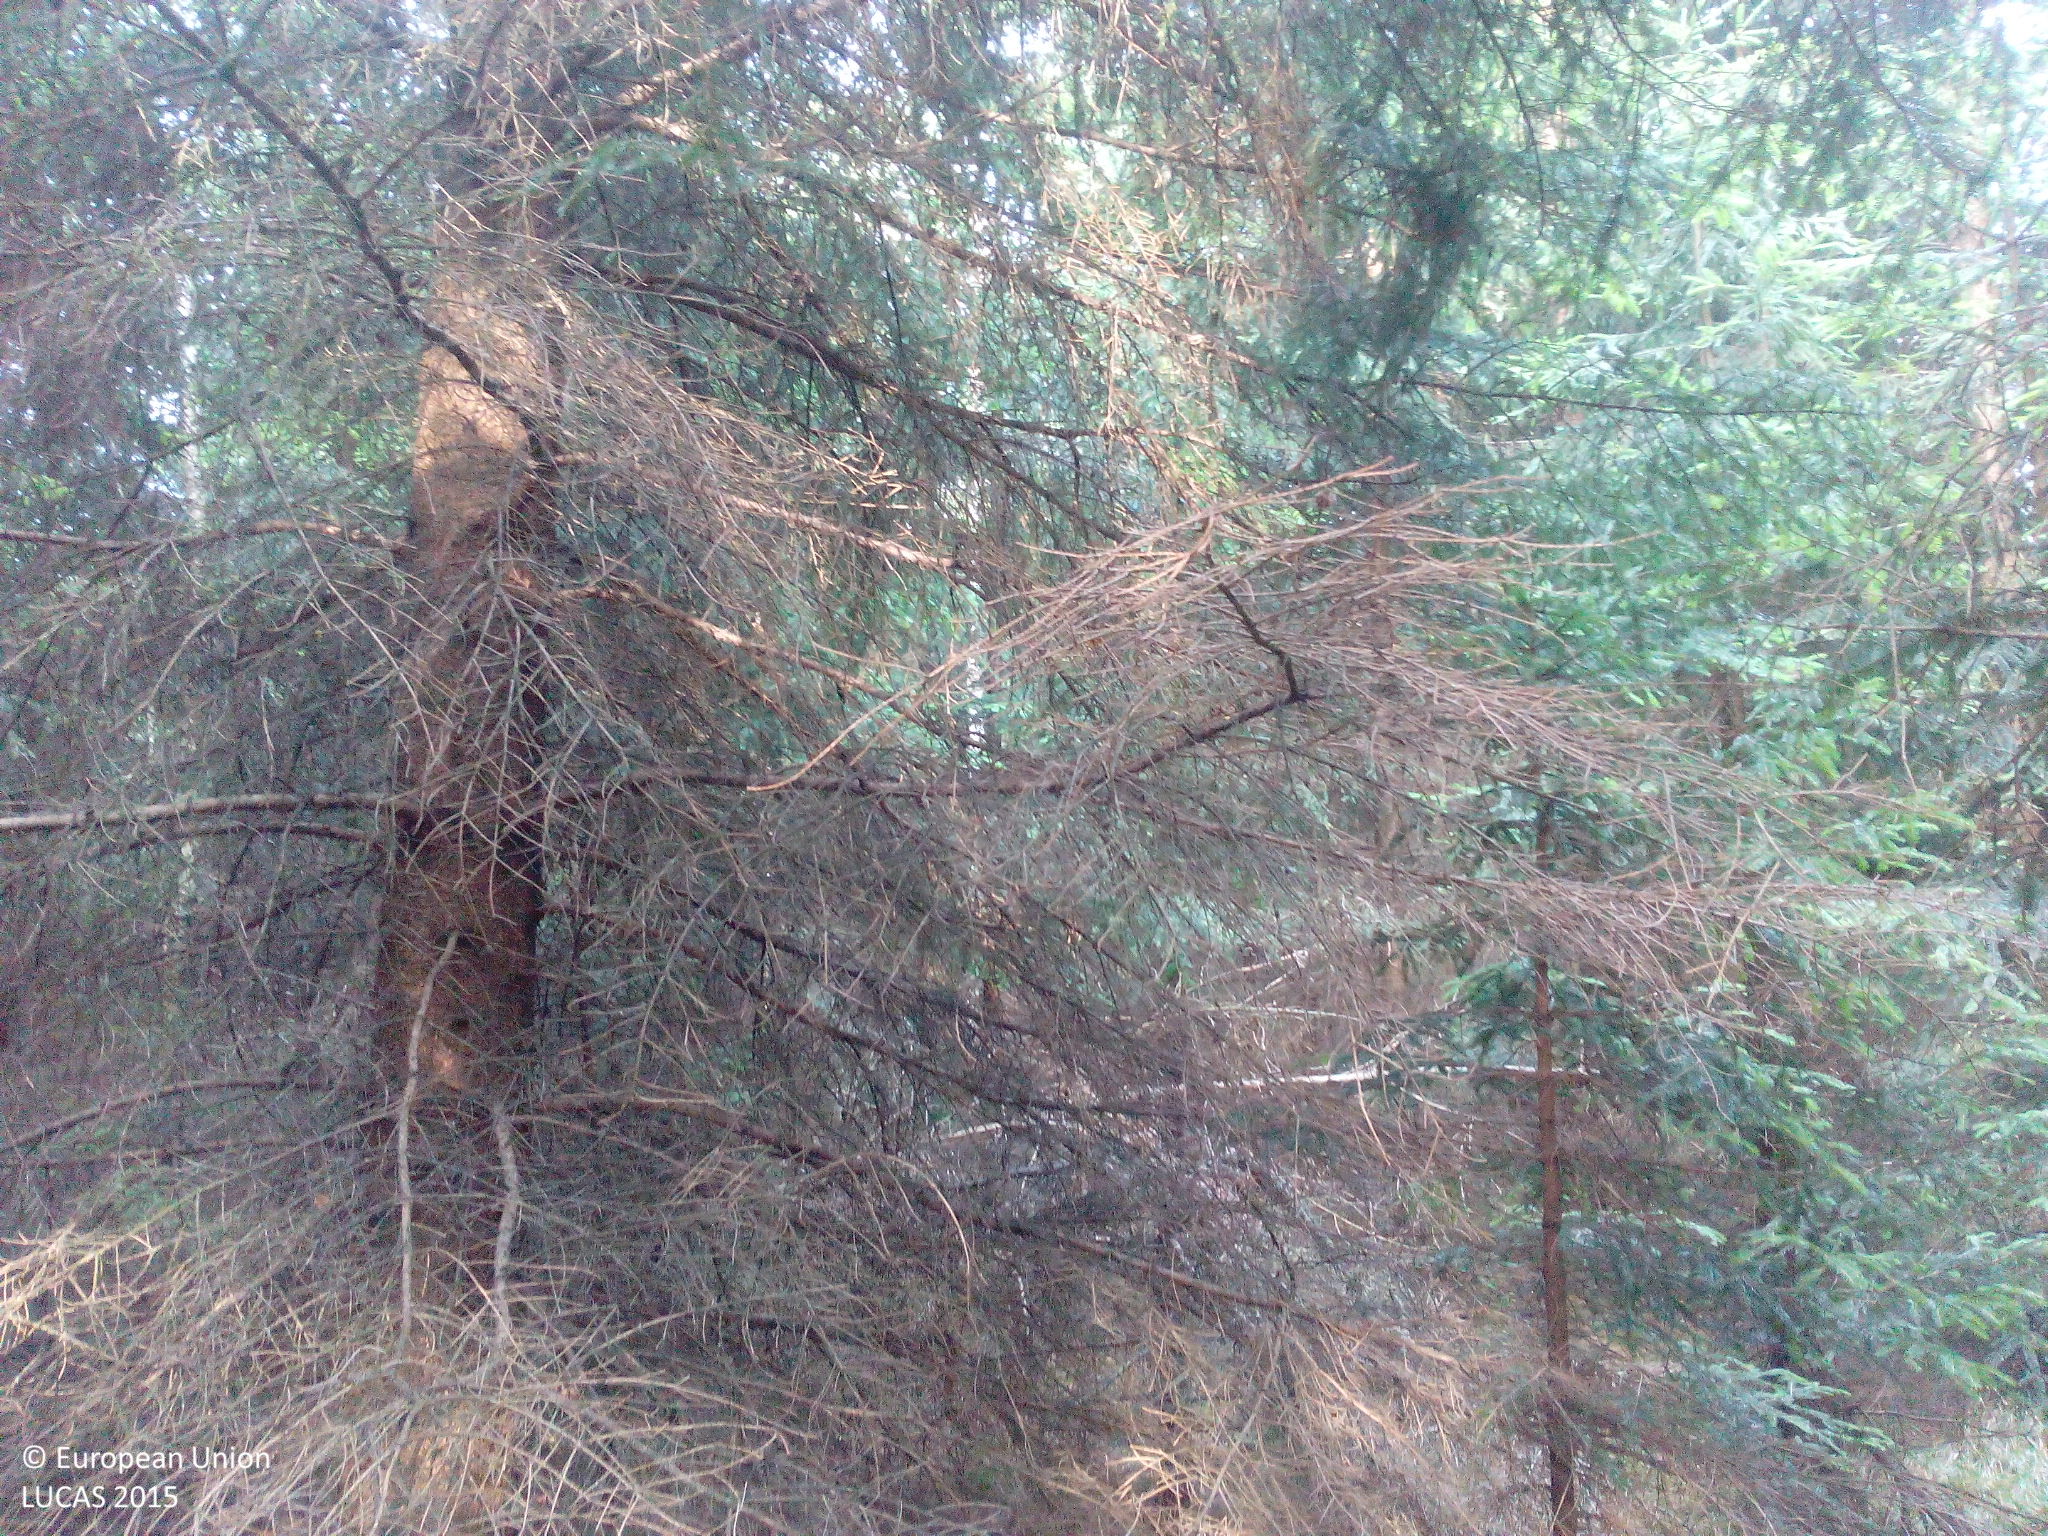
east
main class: Woodland
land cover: Spruce dominated coniferous woodland
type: hemiboreal forest and nemoral coniferous forest and mixed broadleaved-coniferous forest
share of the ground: > 75 %
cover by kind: coniferous forest trees 90 %, herbaceous plants 10 %
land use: Forestry
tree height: > 5 m
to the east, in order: Spruce dominated coniferous woodland; Ditches and canals; Tracks; Ditches and canals; Spruce dominated coniferous woodland; Tracks; Spruce dominated mixed woodland
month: July
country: DE
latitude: 50.9400
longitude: 13.5156
